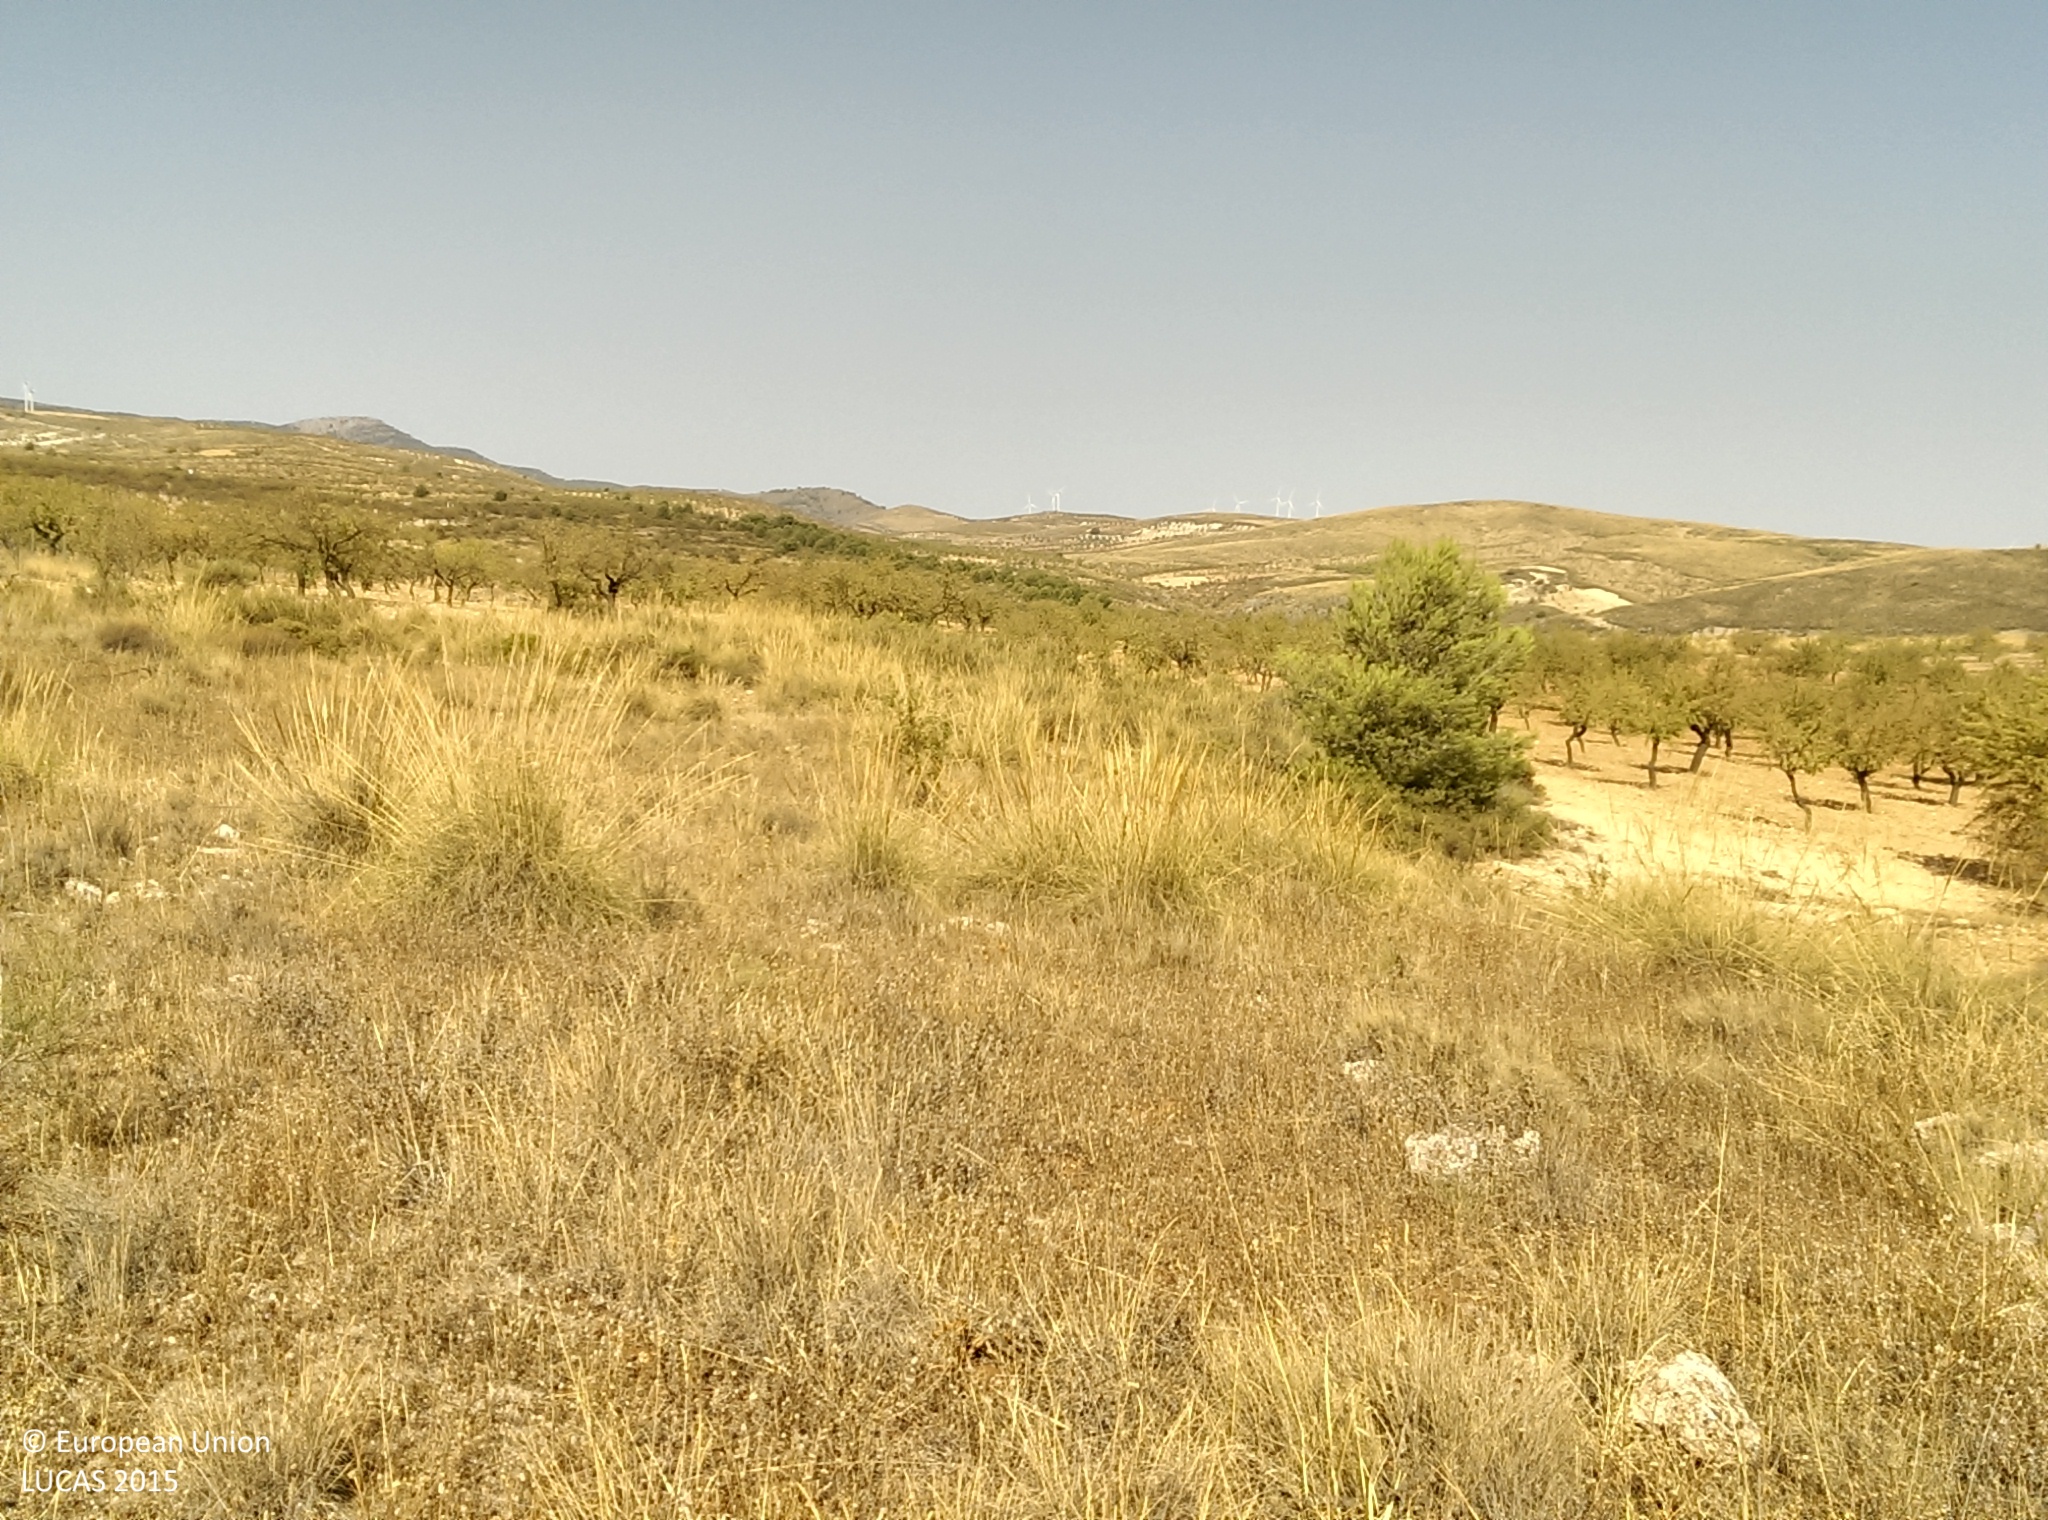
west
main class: Grassland
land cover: Grassland without tree/shrub cover
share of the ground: > 75 %
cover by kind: herbaceous plants 95 %, shrubs 5 %
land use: Abandoned areas
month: August
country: ES
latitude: 36.9661
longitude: -3.6103
